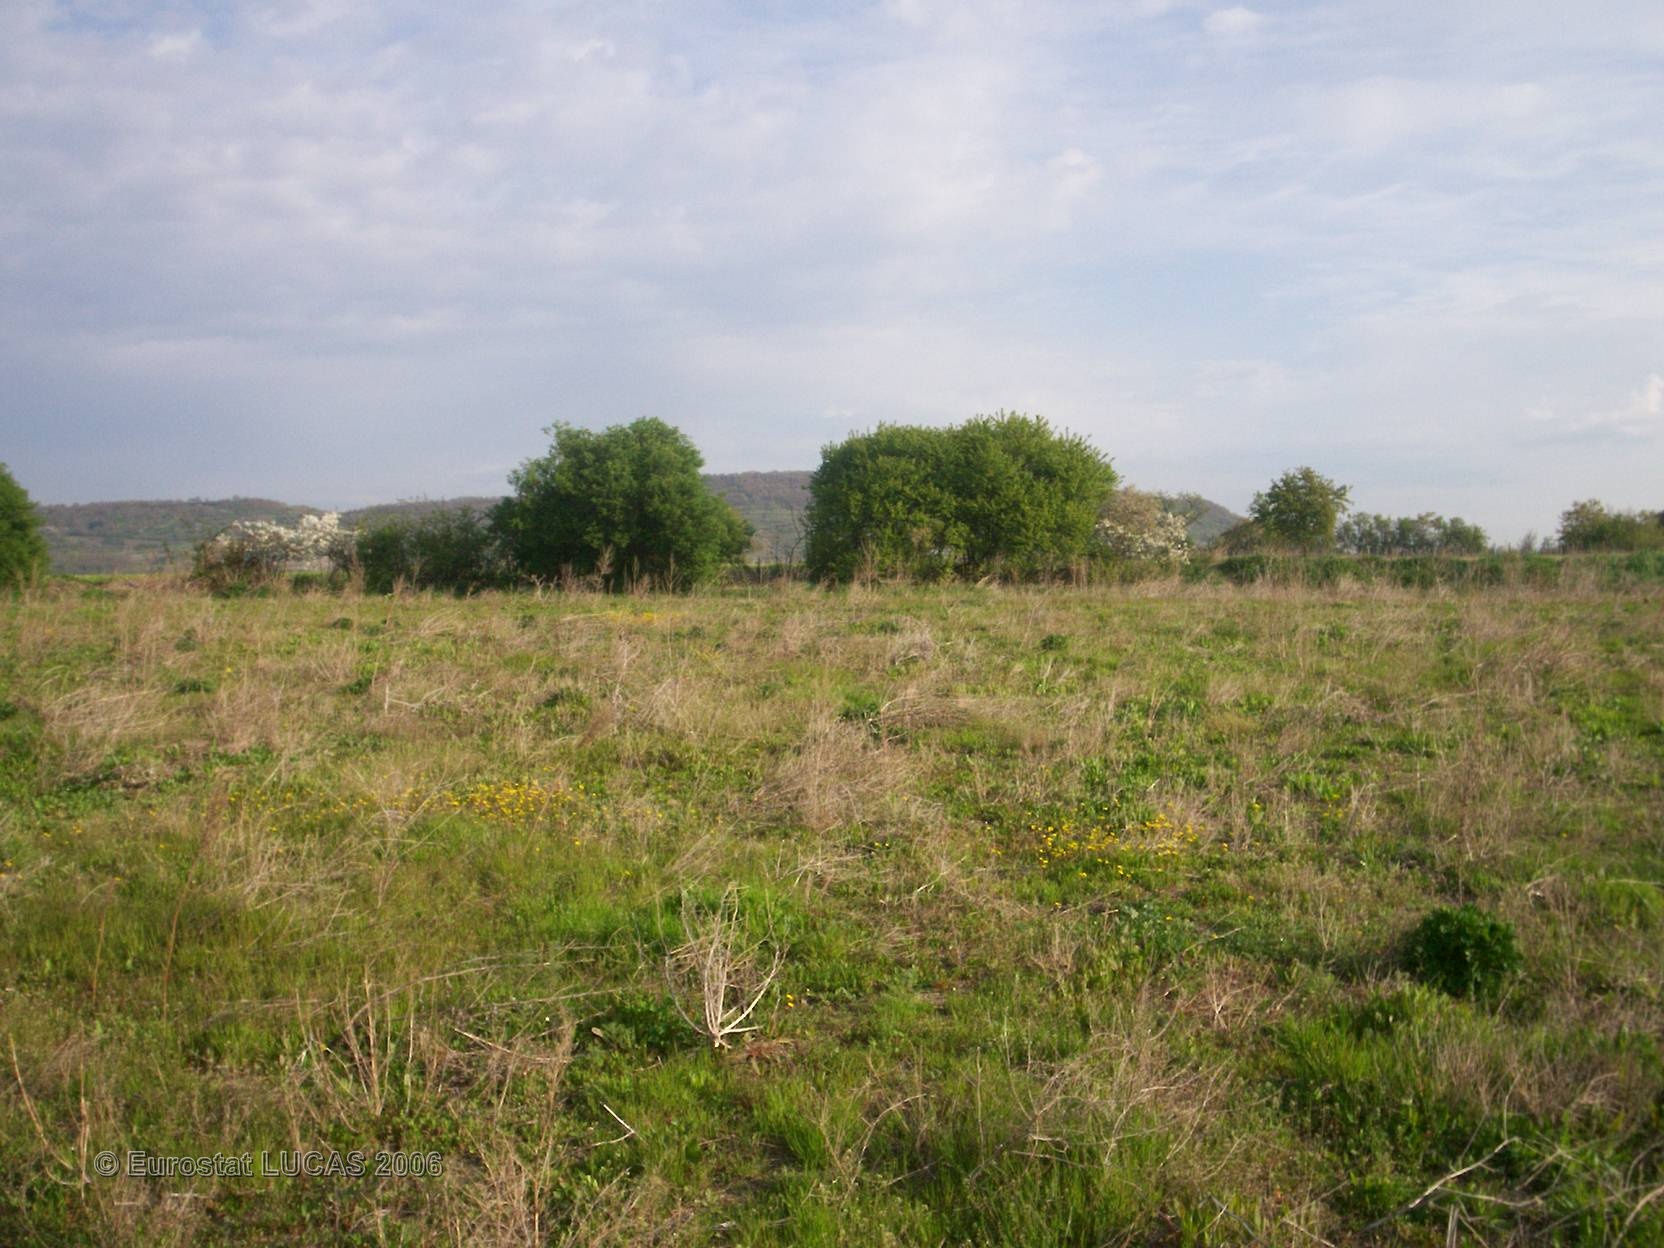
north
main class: Grassland
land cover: Grassland without tree/shrub cover
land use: Fallow land
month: April
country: FR
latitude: 45.8398
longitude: 3.1113
